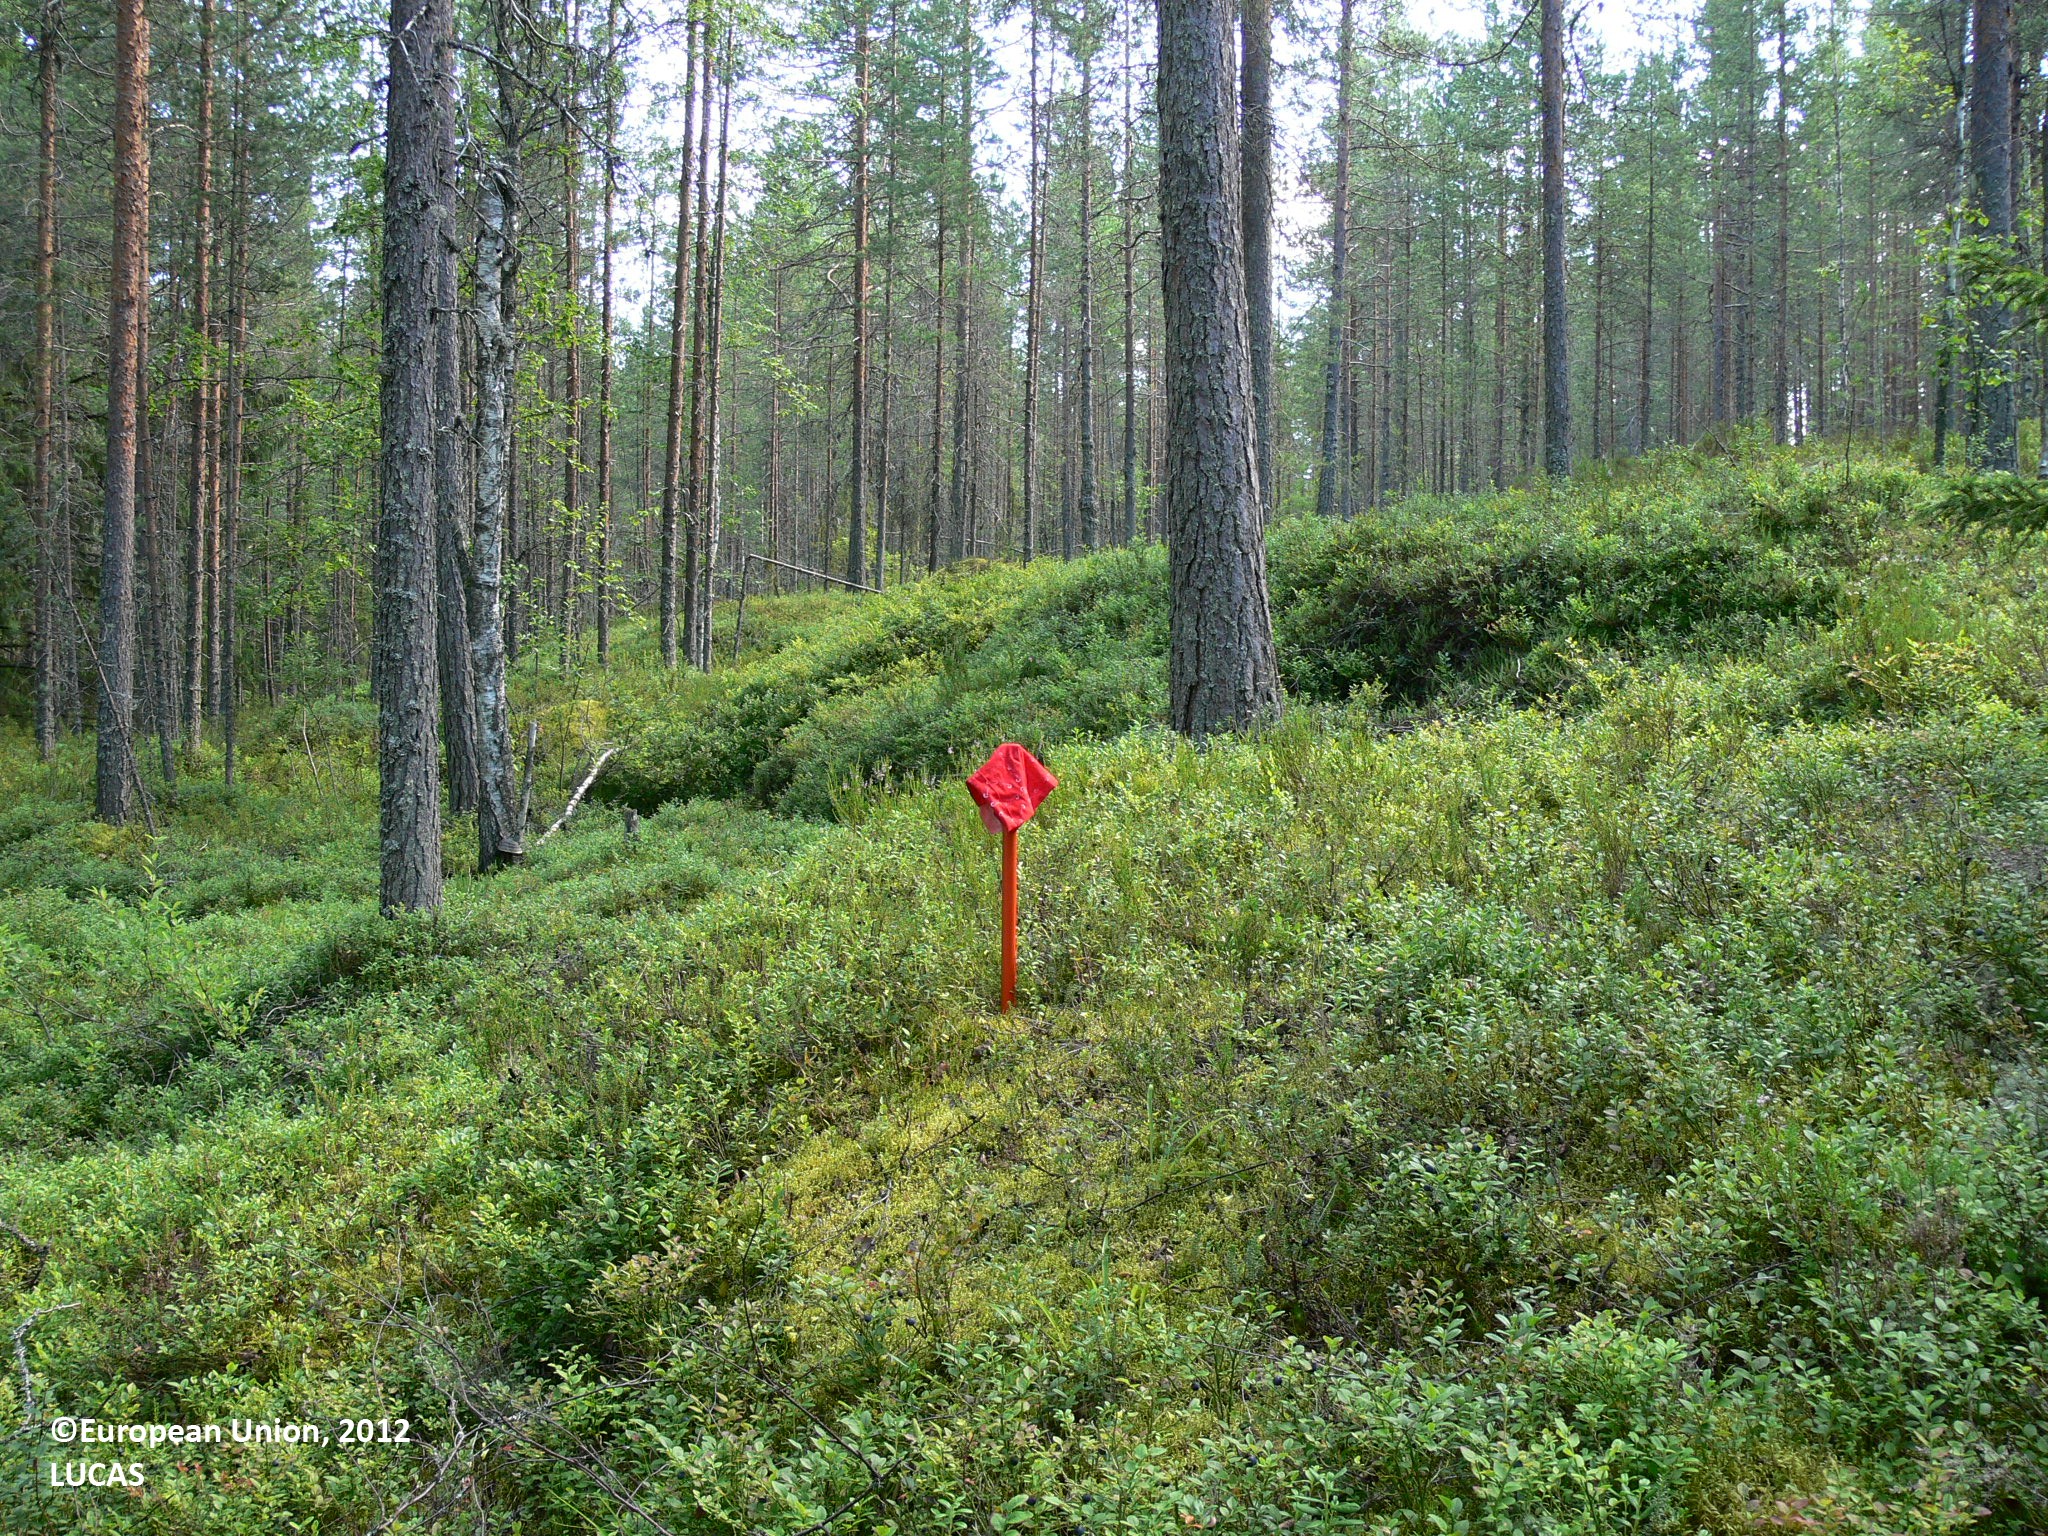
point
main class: Woodland
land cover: Pine dominated coniferous woodland
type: boreal forest
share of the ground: 50 - 75 %
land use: Forestry
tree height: > 5 m
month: July
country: FI
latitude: 63.2866
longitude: 29.3040
